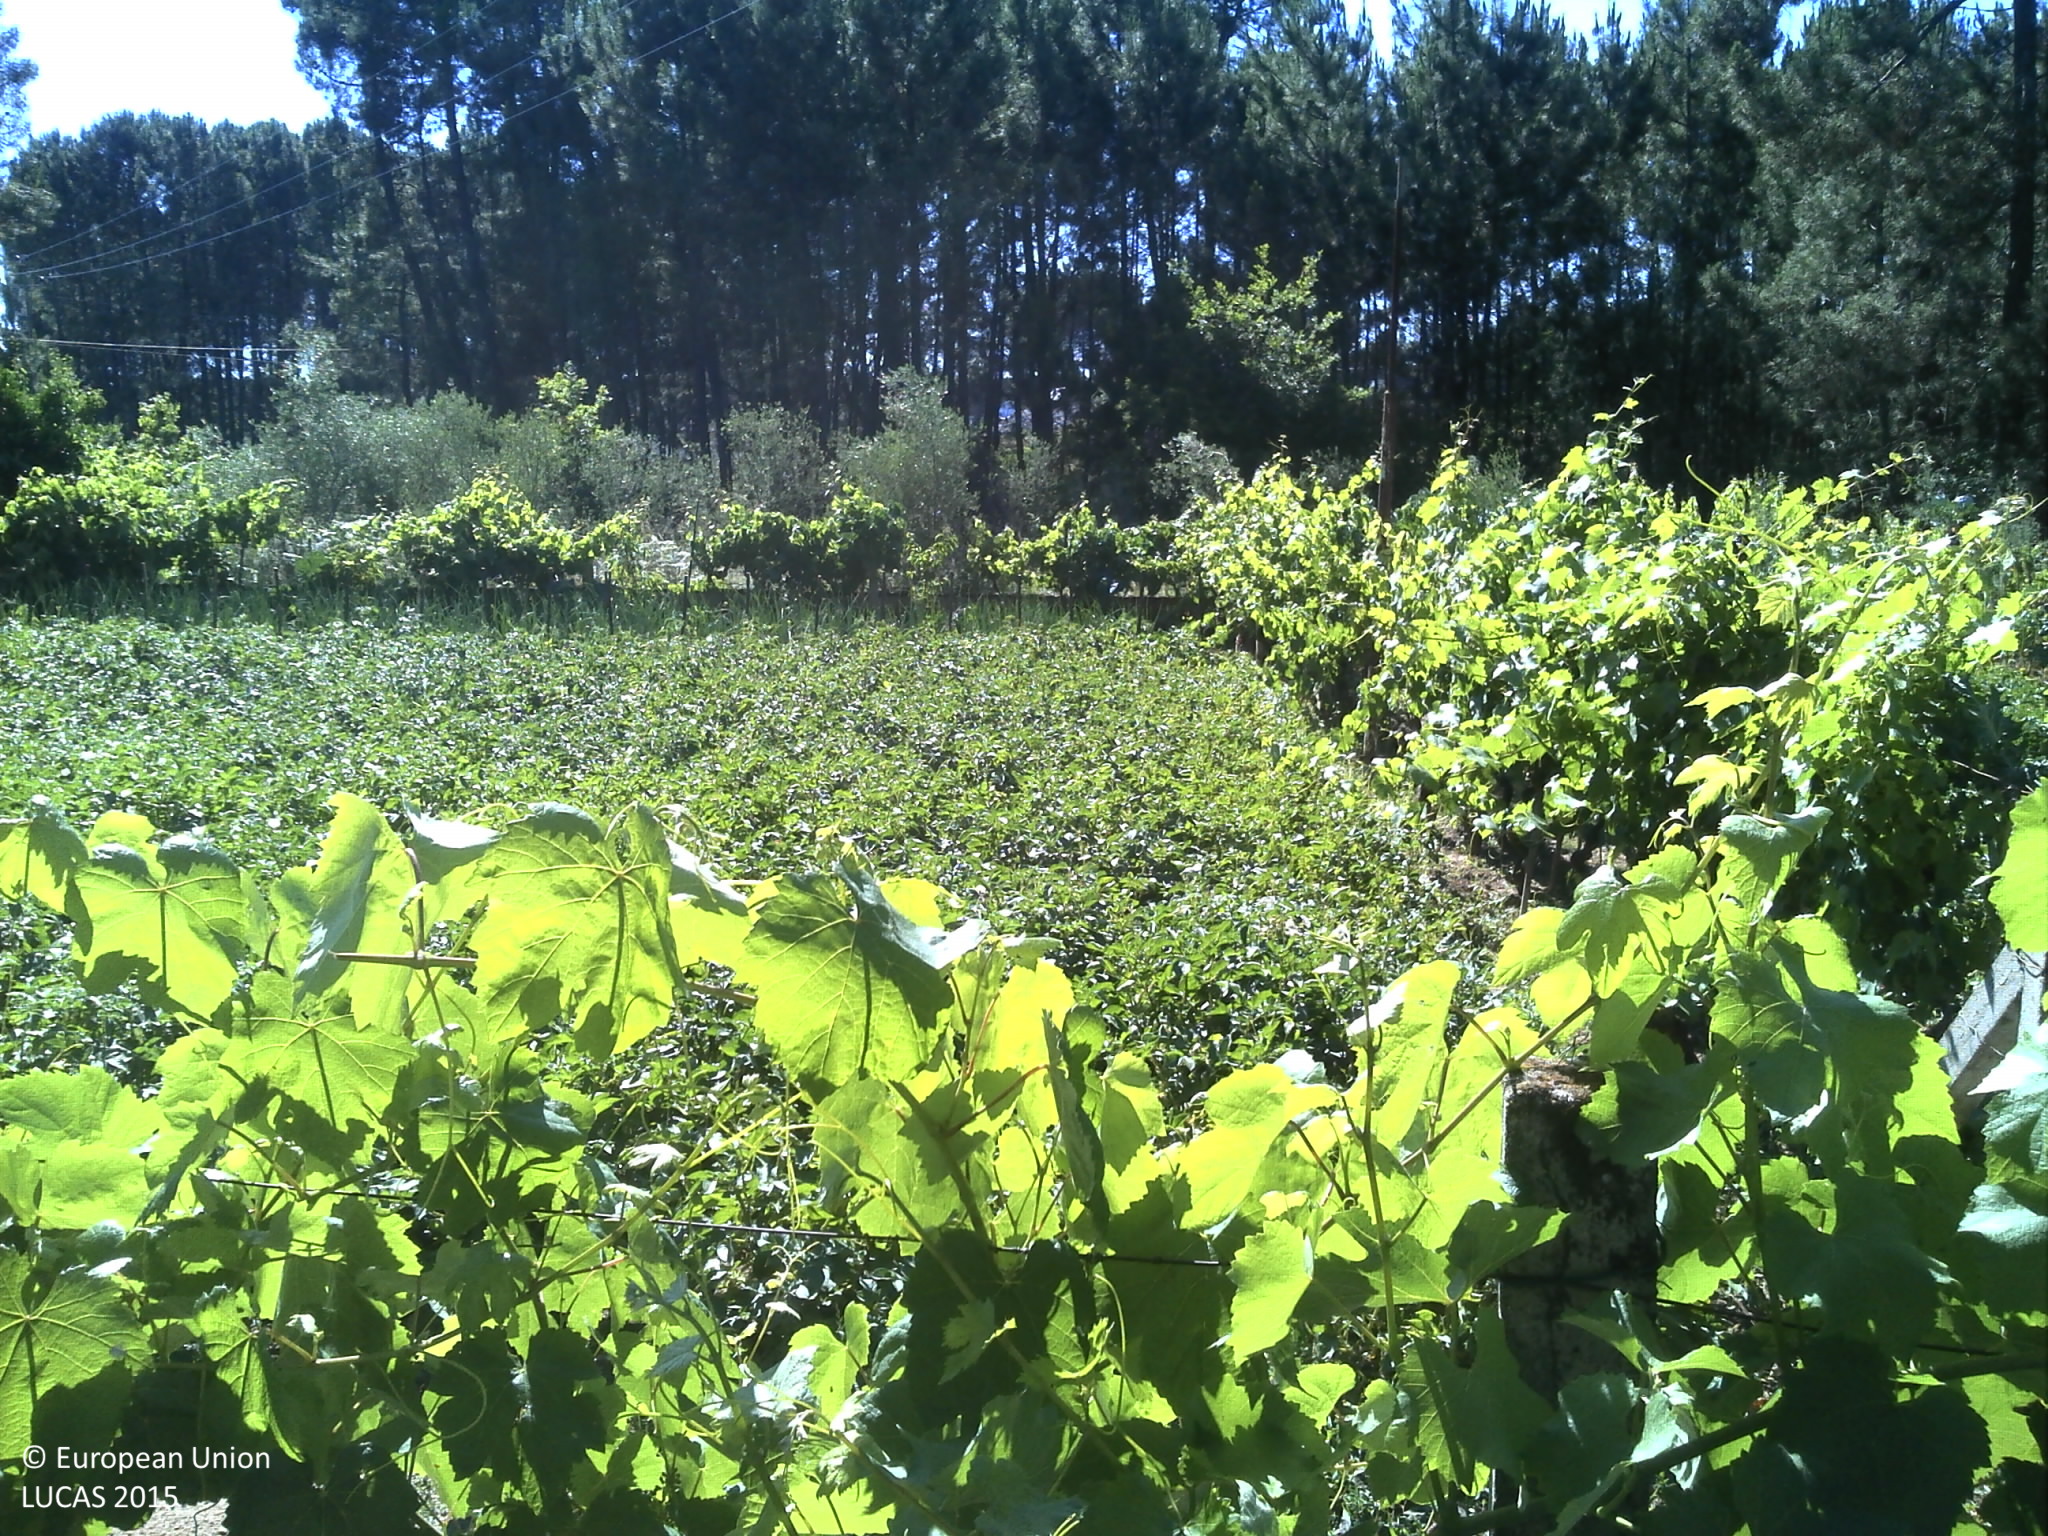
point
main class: Cropland
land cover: Potatoes
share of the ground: > 75 %
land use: Agriculture (excluding fallow land and kitchen gardens)
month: June
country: PT
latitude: 40.7306
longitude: -7.8977
